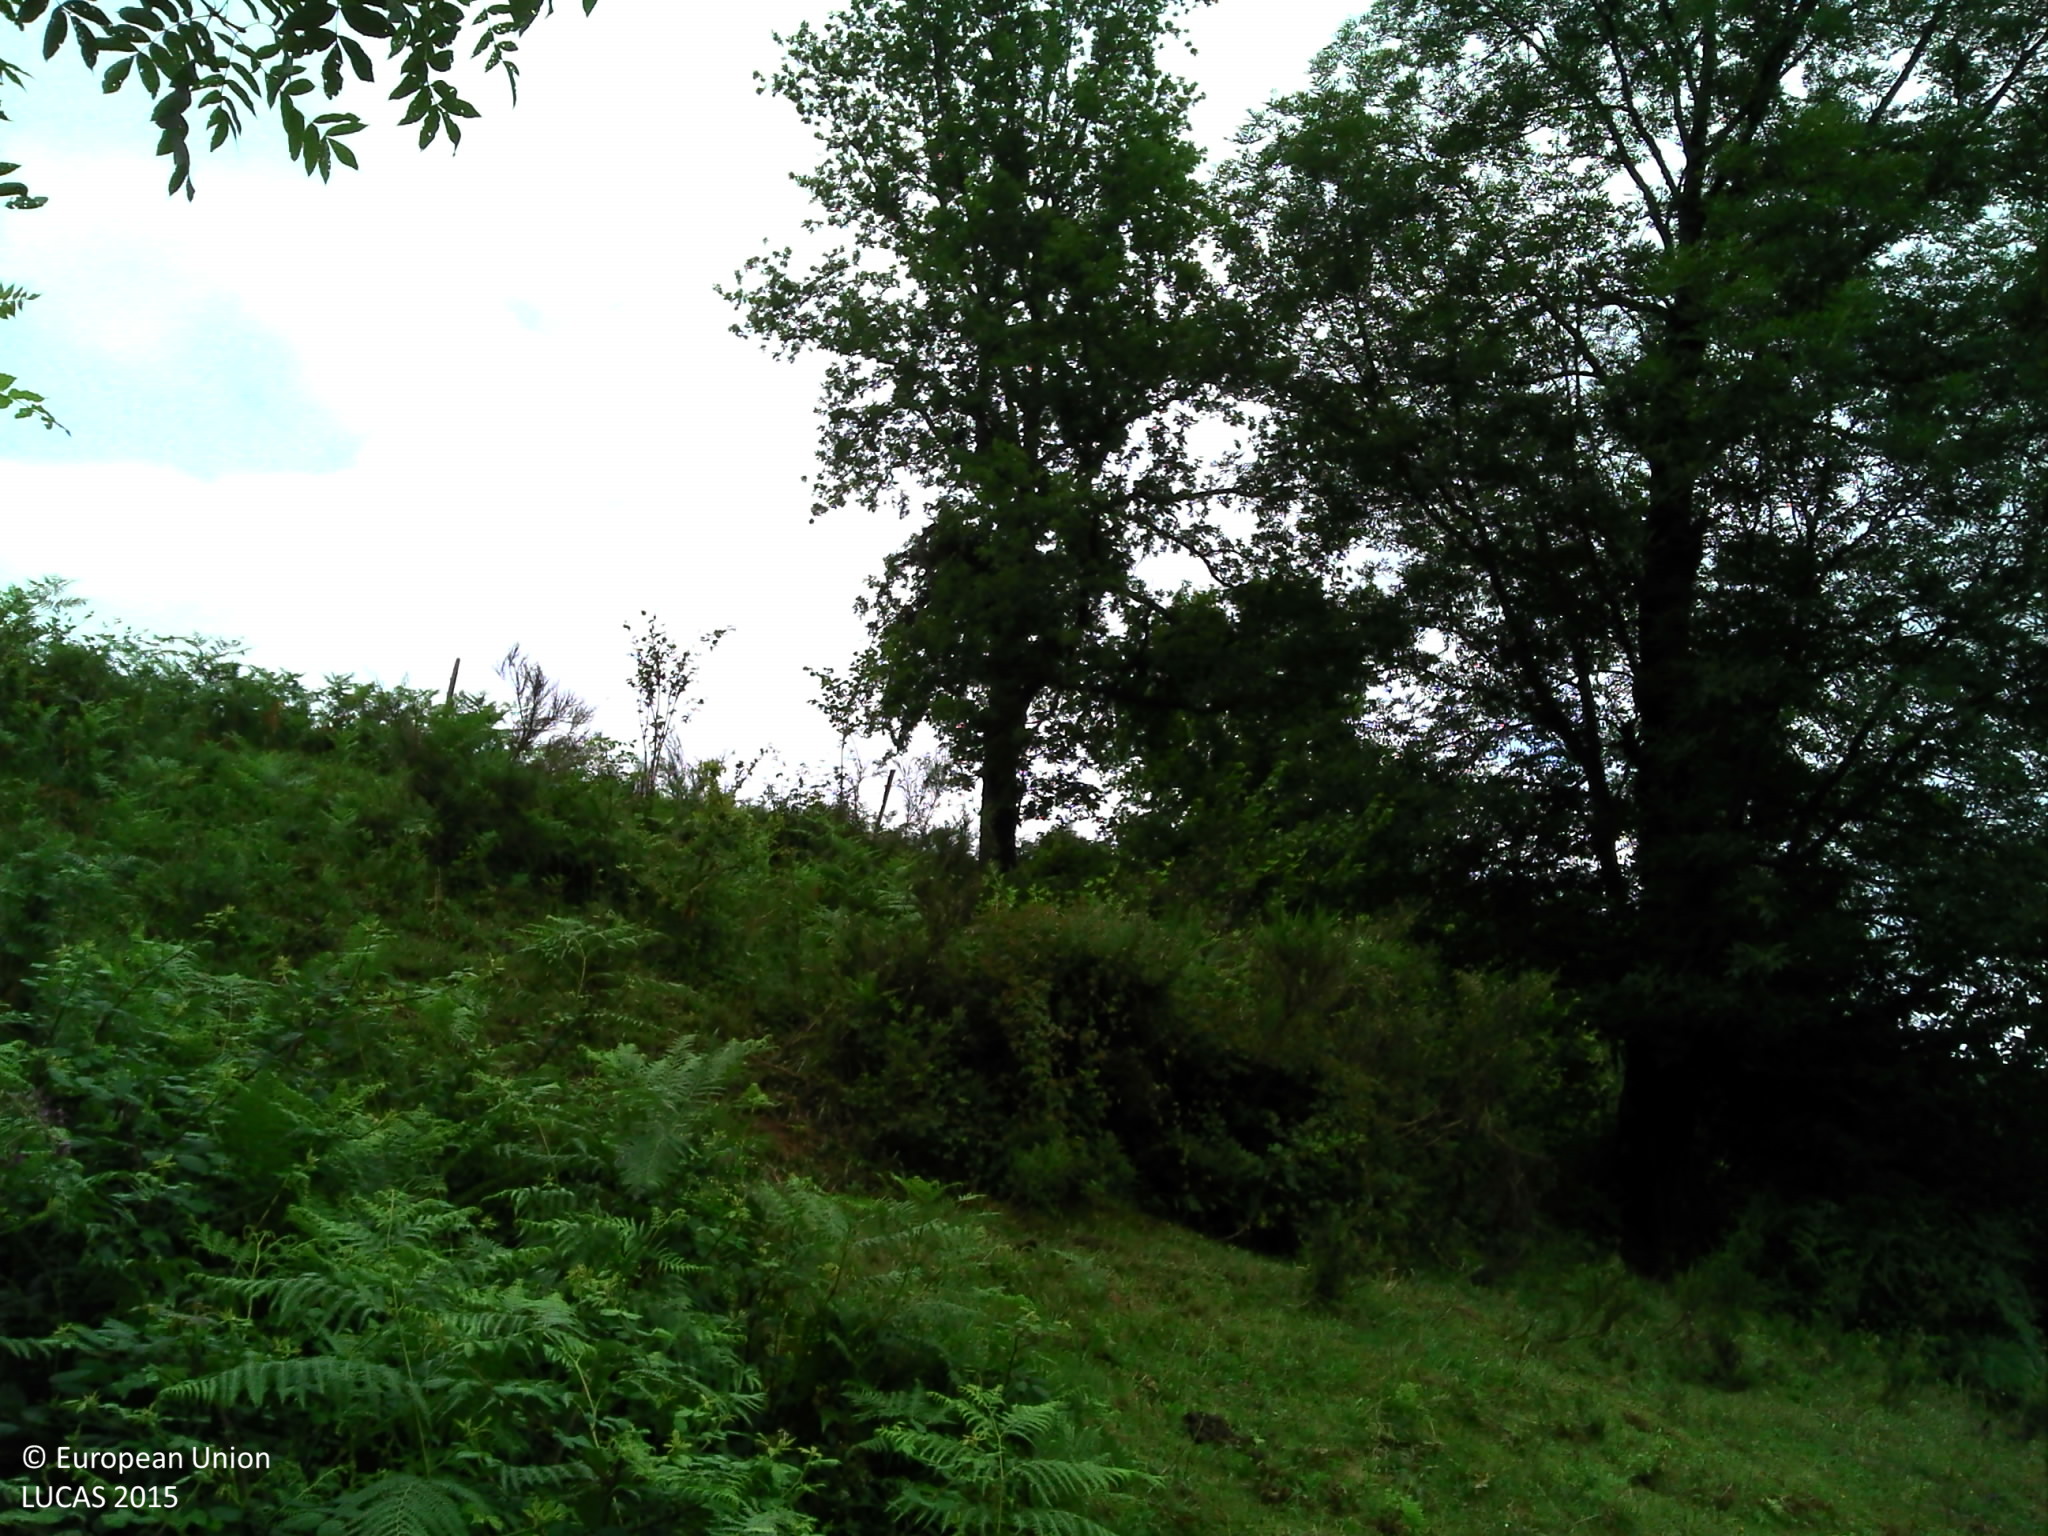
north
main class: Grassland
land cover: Grassland with sparse tree/shrub cover
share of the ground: > 75 %
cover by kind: herbaceous plants 90 %, broadleaved forest trees 5 %, shrubs 5 %
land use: Agriculture (excluding fallow land and kitchen gardens)
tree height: > 5 m
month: July
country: FR
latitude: 42.8835
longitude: 1.1533
